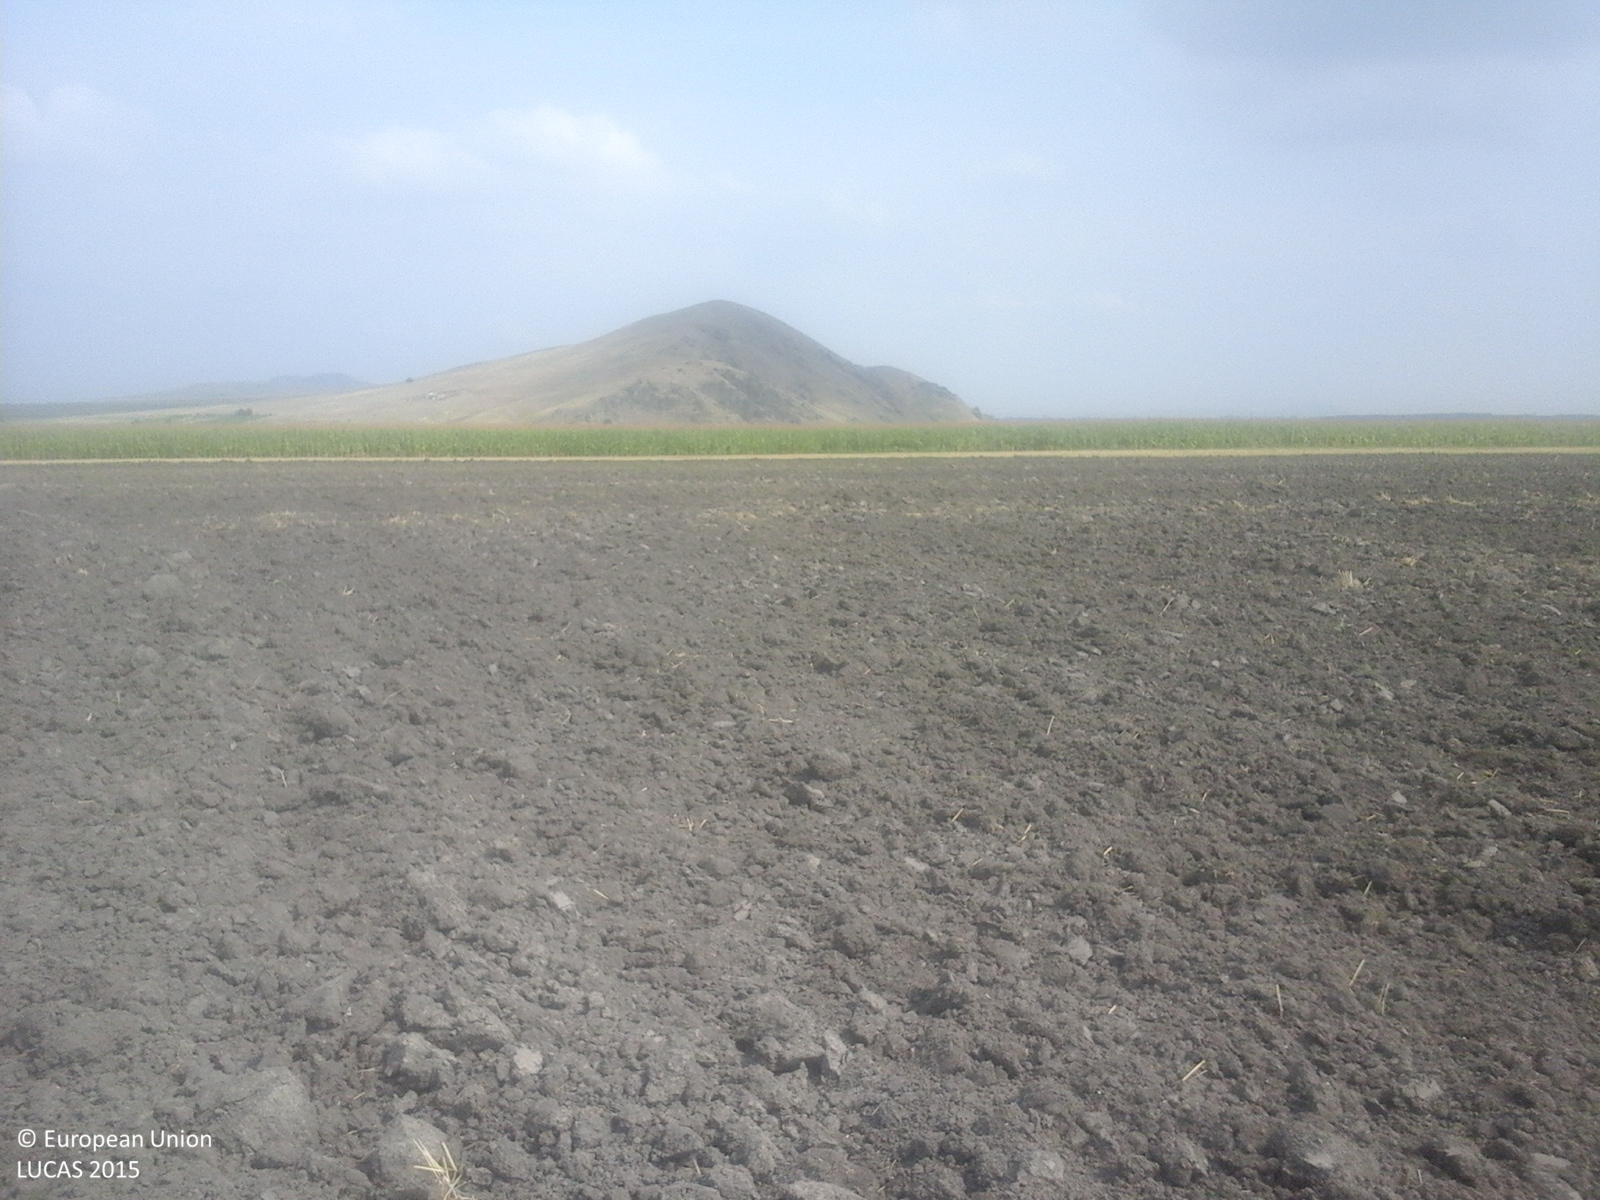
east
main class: Cropland
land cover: Common wheat
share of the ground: < 10 %
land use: Agriculture (excluding fallow land and kitchen gardens)
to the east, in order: Common wheat; Tracks; Common wheat; Maize; Common wheat; Maize; Sunflower; Common wheat
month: July
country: RO
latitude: 45.2910
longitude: 28.0839
